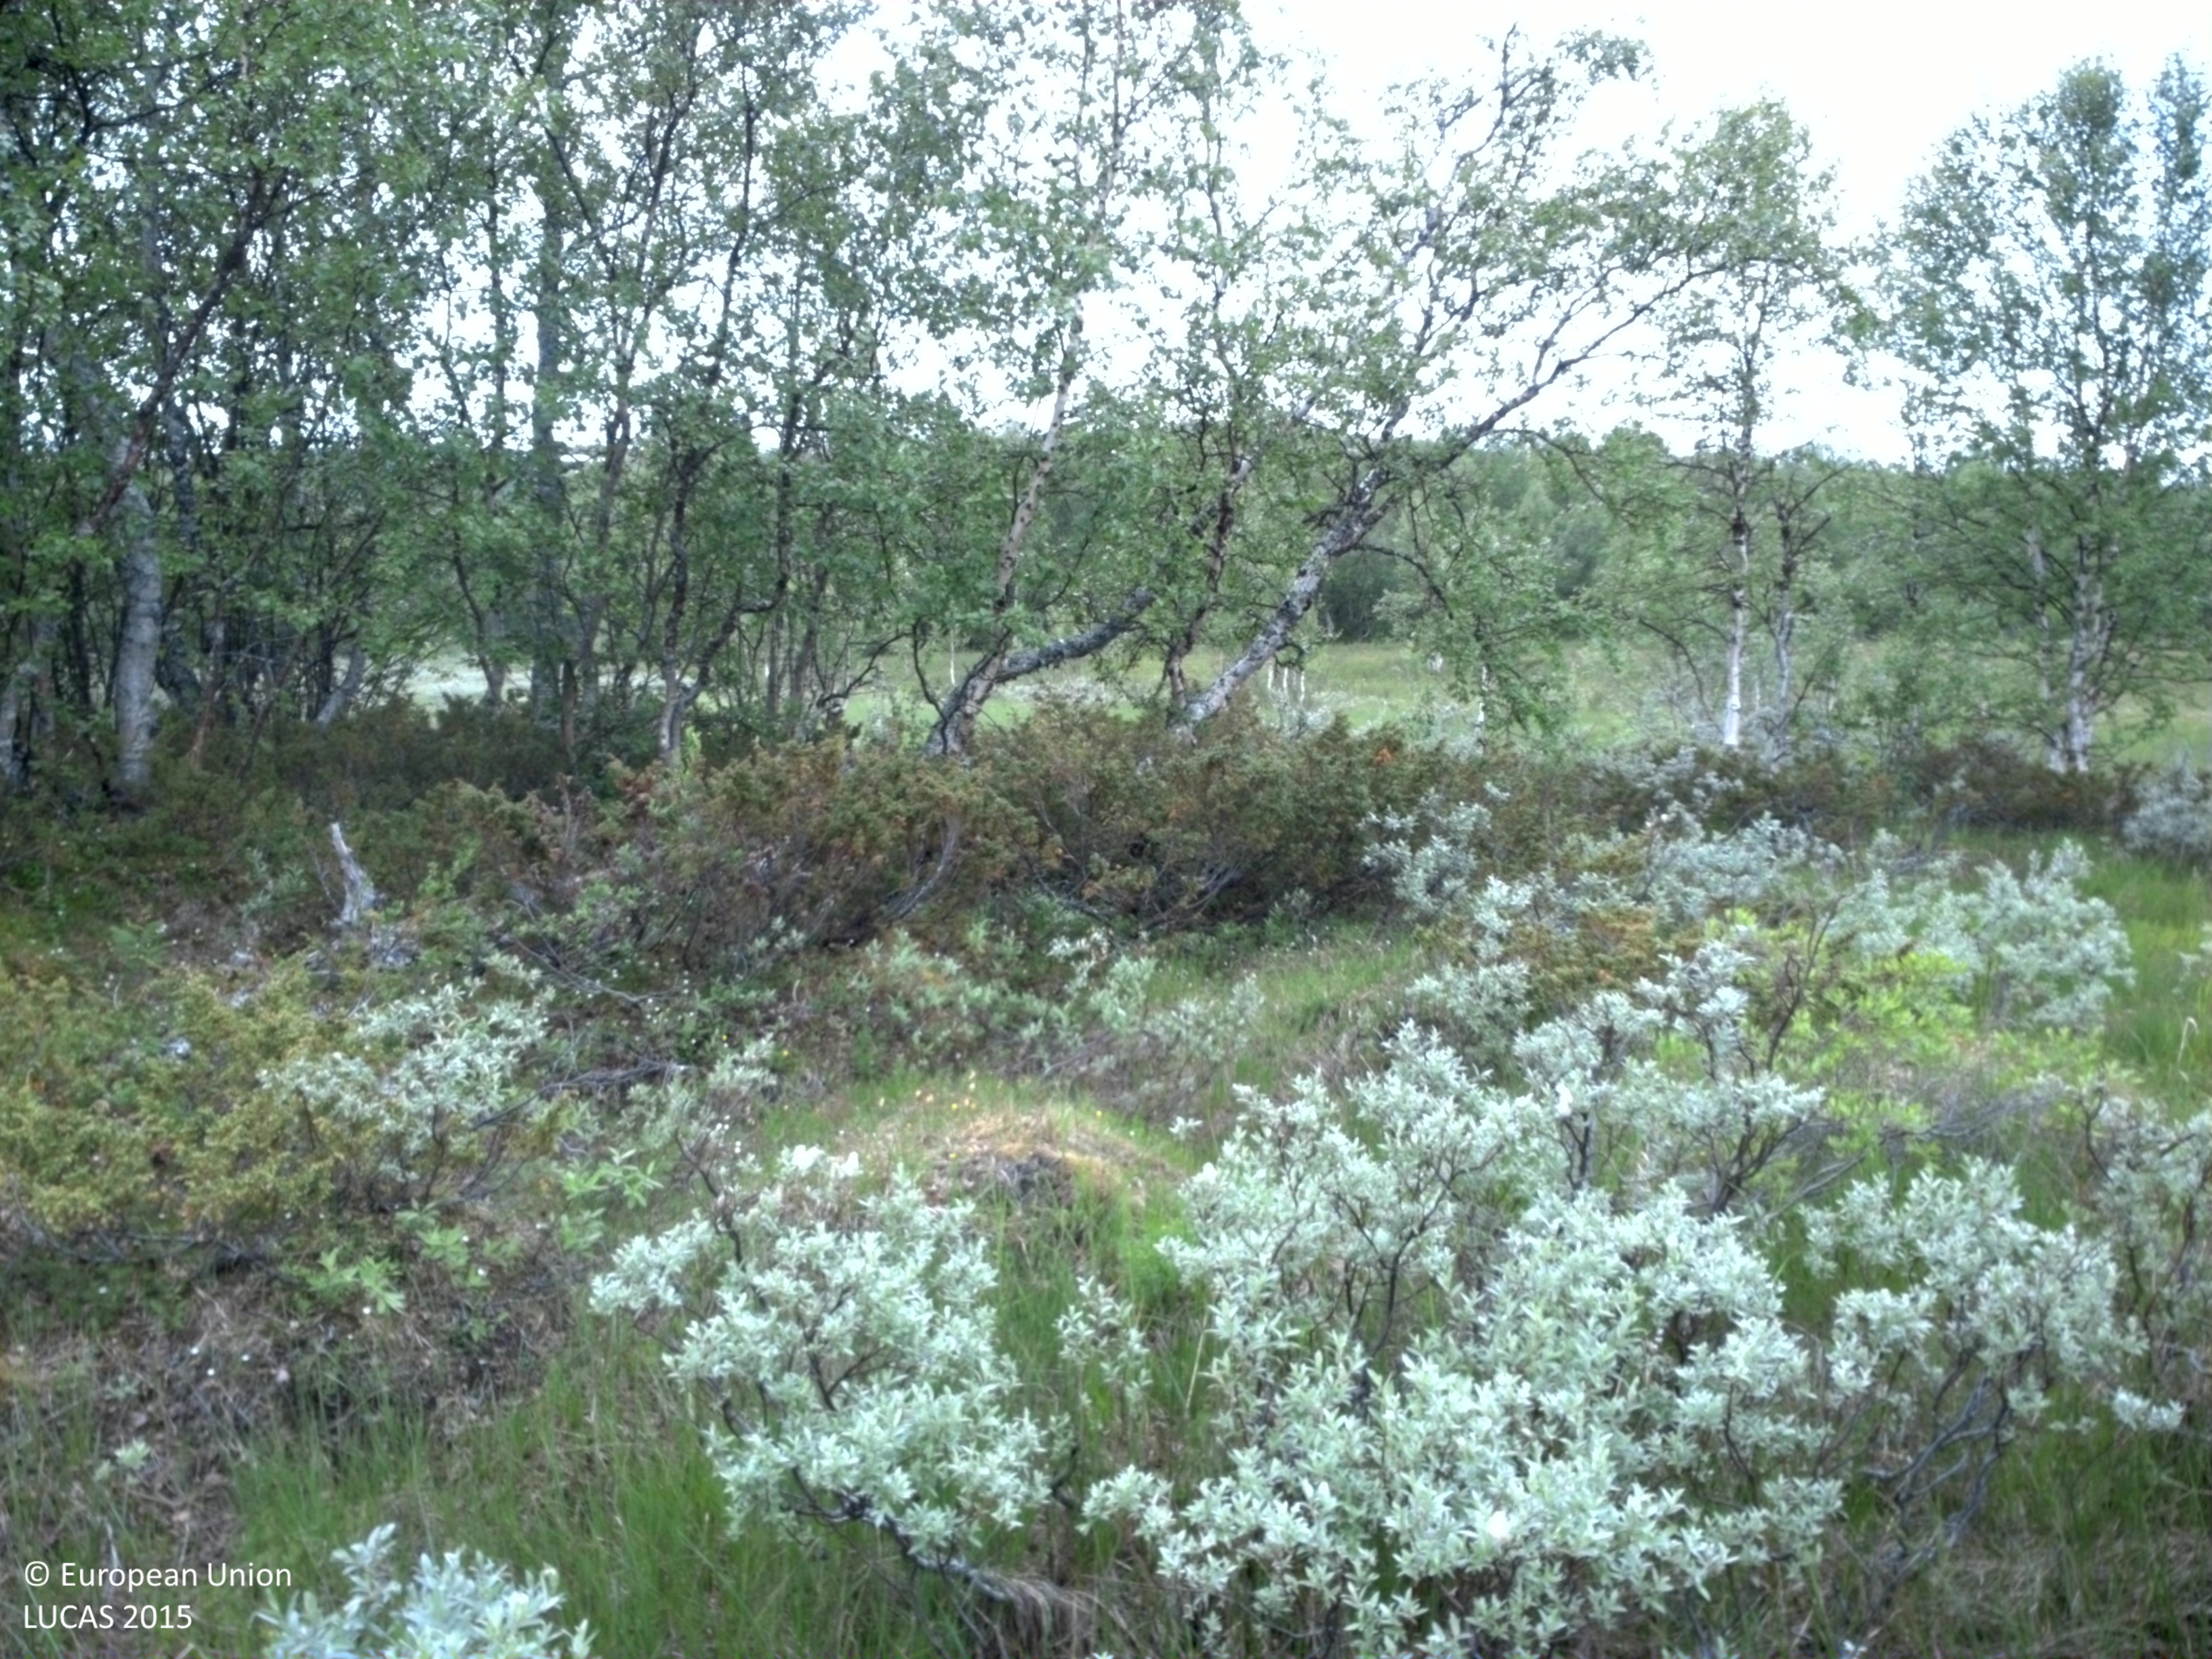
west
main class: Shrubland
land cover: Shrubland without tree cover
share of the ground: 50 - 75 %
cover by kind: shrubs 50 %, herbaceous plants 50 %
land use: Semi-natural and natural areas not in use
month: July
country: SE
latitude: 65.7636
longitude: 15.1388
